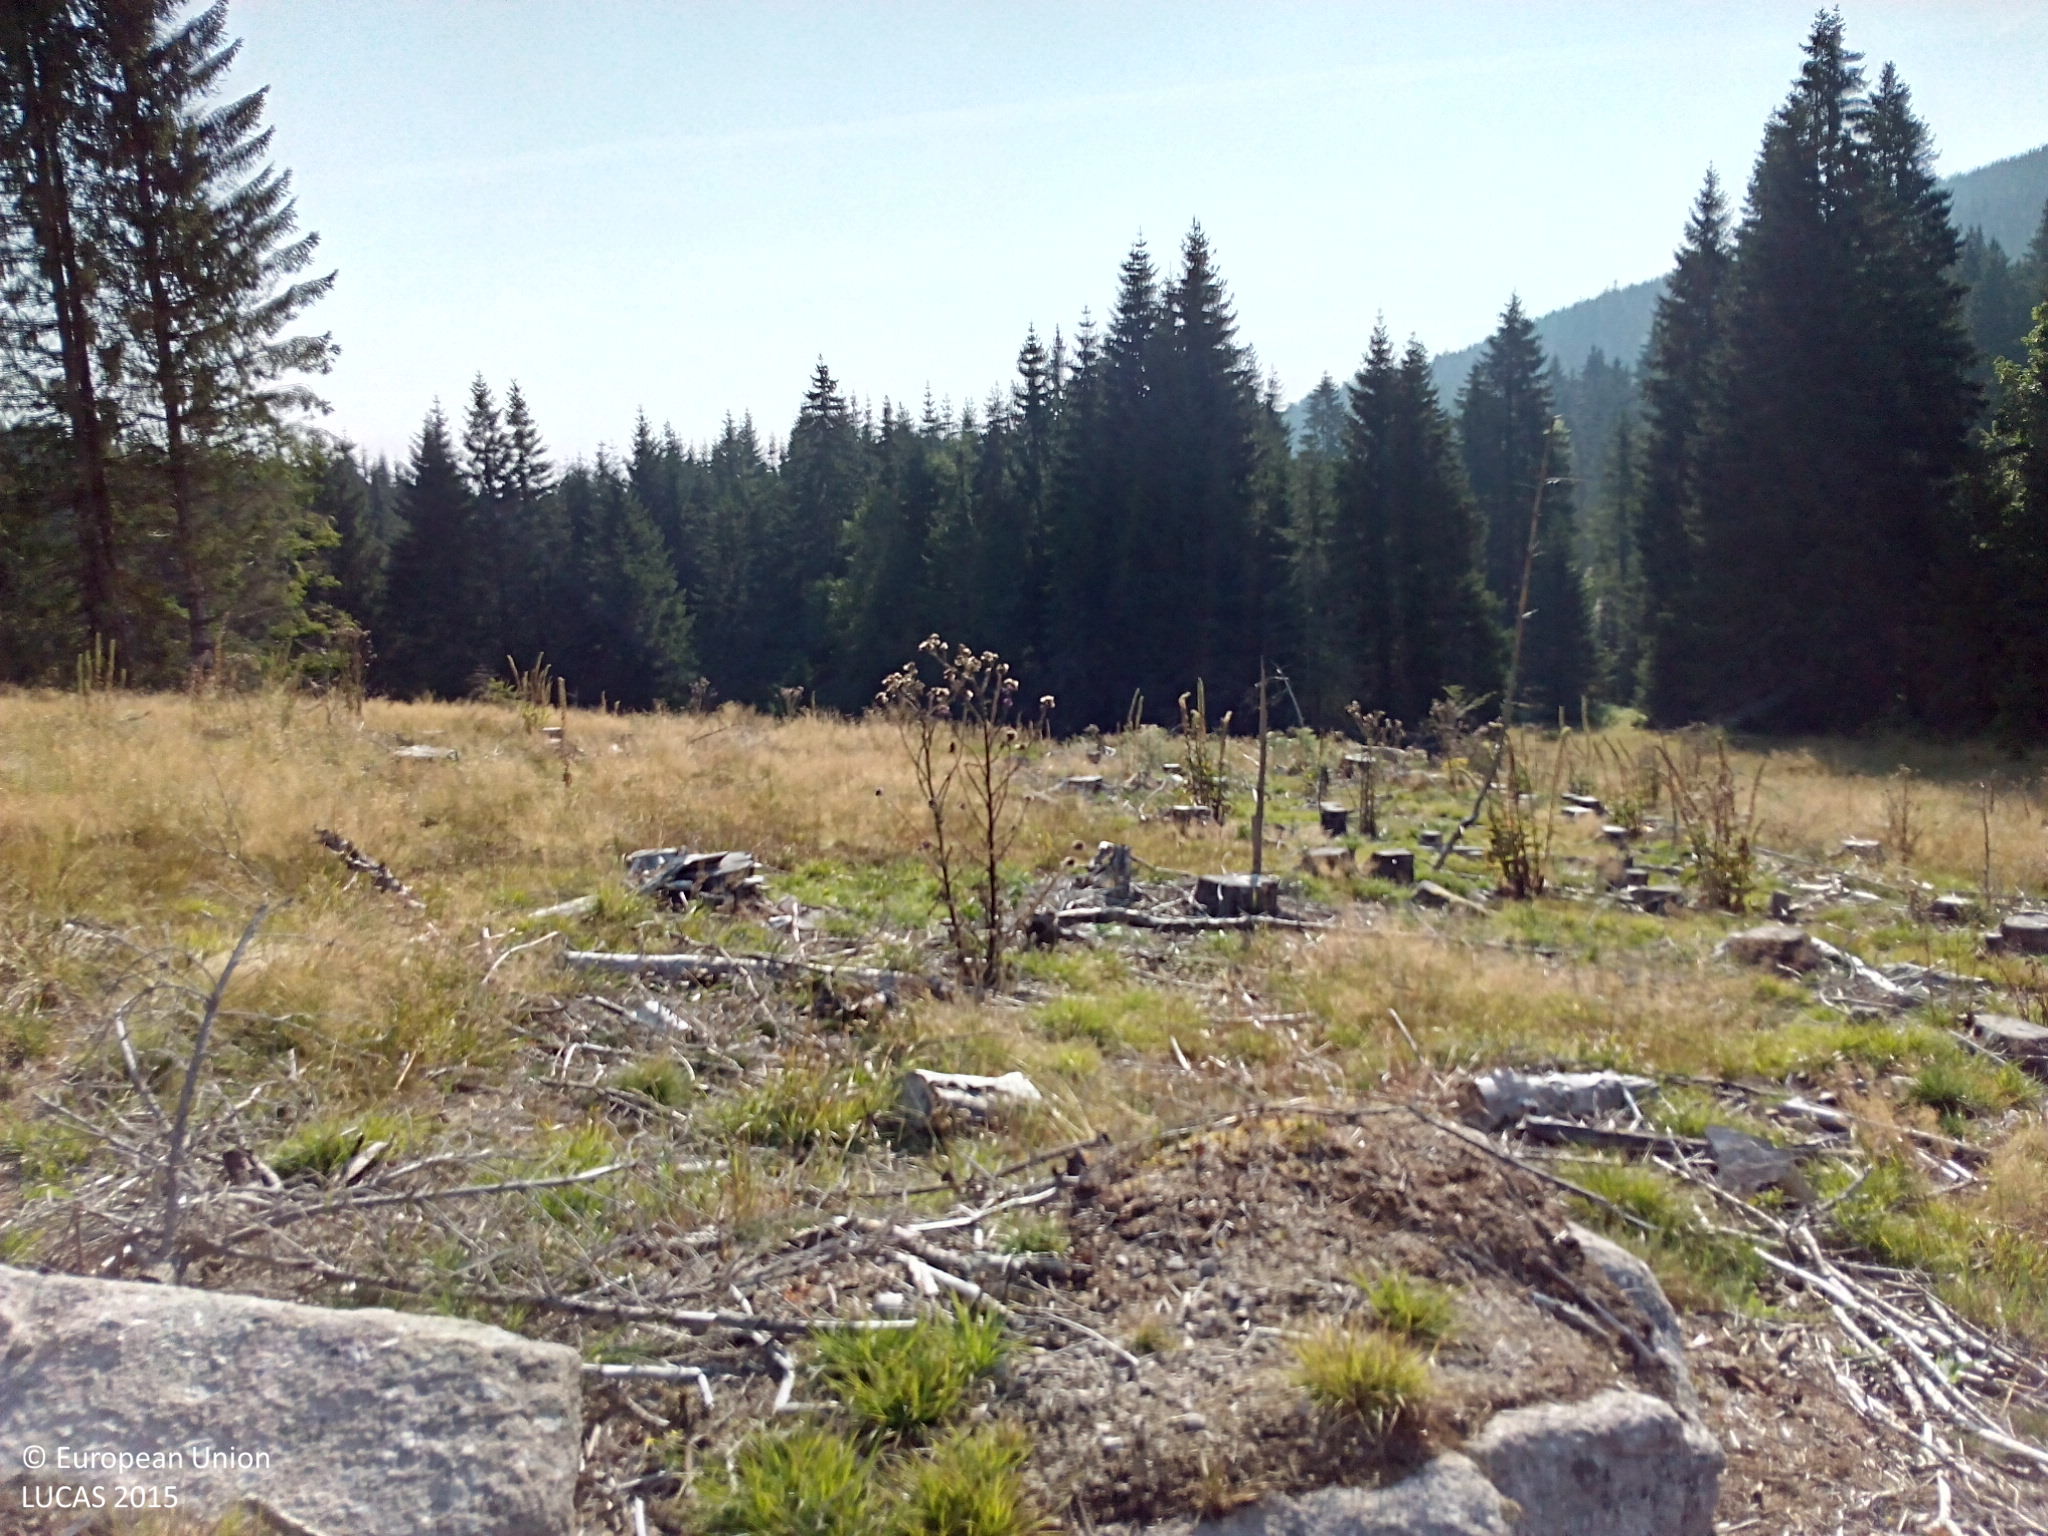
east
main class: Grassland
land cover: Spontaneously vegetated surfaces
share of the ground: 50 - 75 %
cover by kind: herbaceous plants 50 %, unconsolidated bare surface 50 %
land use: Forestry
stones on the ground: 10 - 25 %
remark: Clear cut
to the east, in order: Spontaneously vegetated surfaces; Grassland without tree/shrub cover; Inland marshes; Spontaneously vegetated surfaces; Rivers and streams; Spruce dominated coniferous woodland; Rivers and streams; Spruce dominated coniferous woodland; Rivers and streams; Spruce dominated coniferous woodland; Grassland without tree/shrub cover; Spruce dominated coniferous woodland; Spontaneously vegetated surfaces
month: August
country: DE
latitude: 47.8115
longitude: 8.1183
